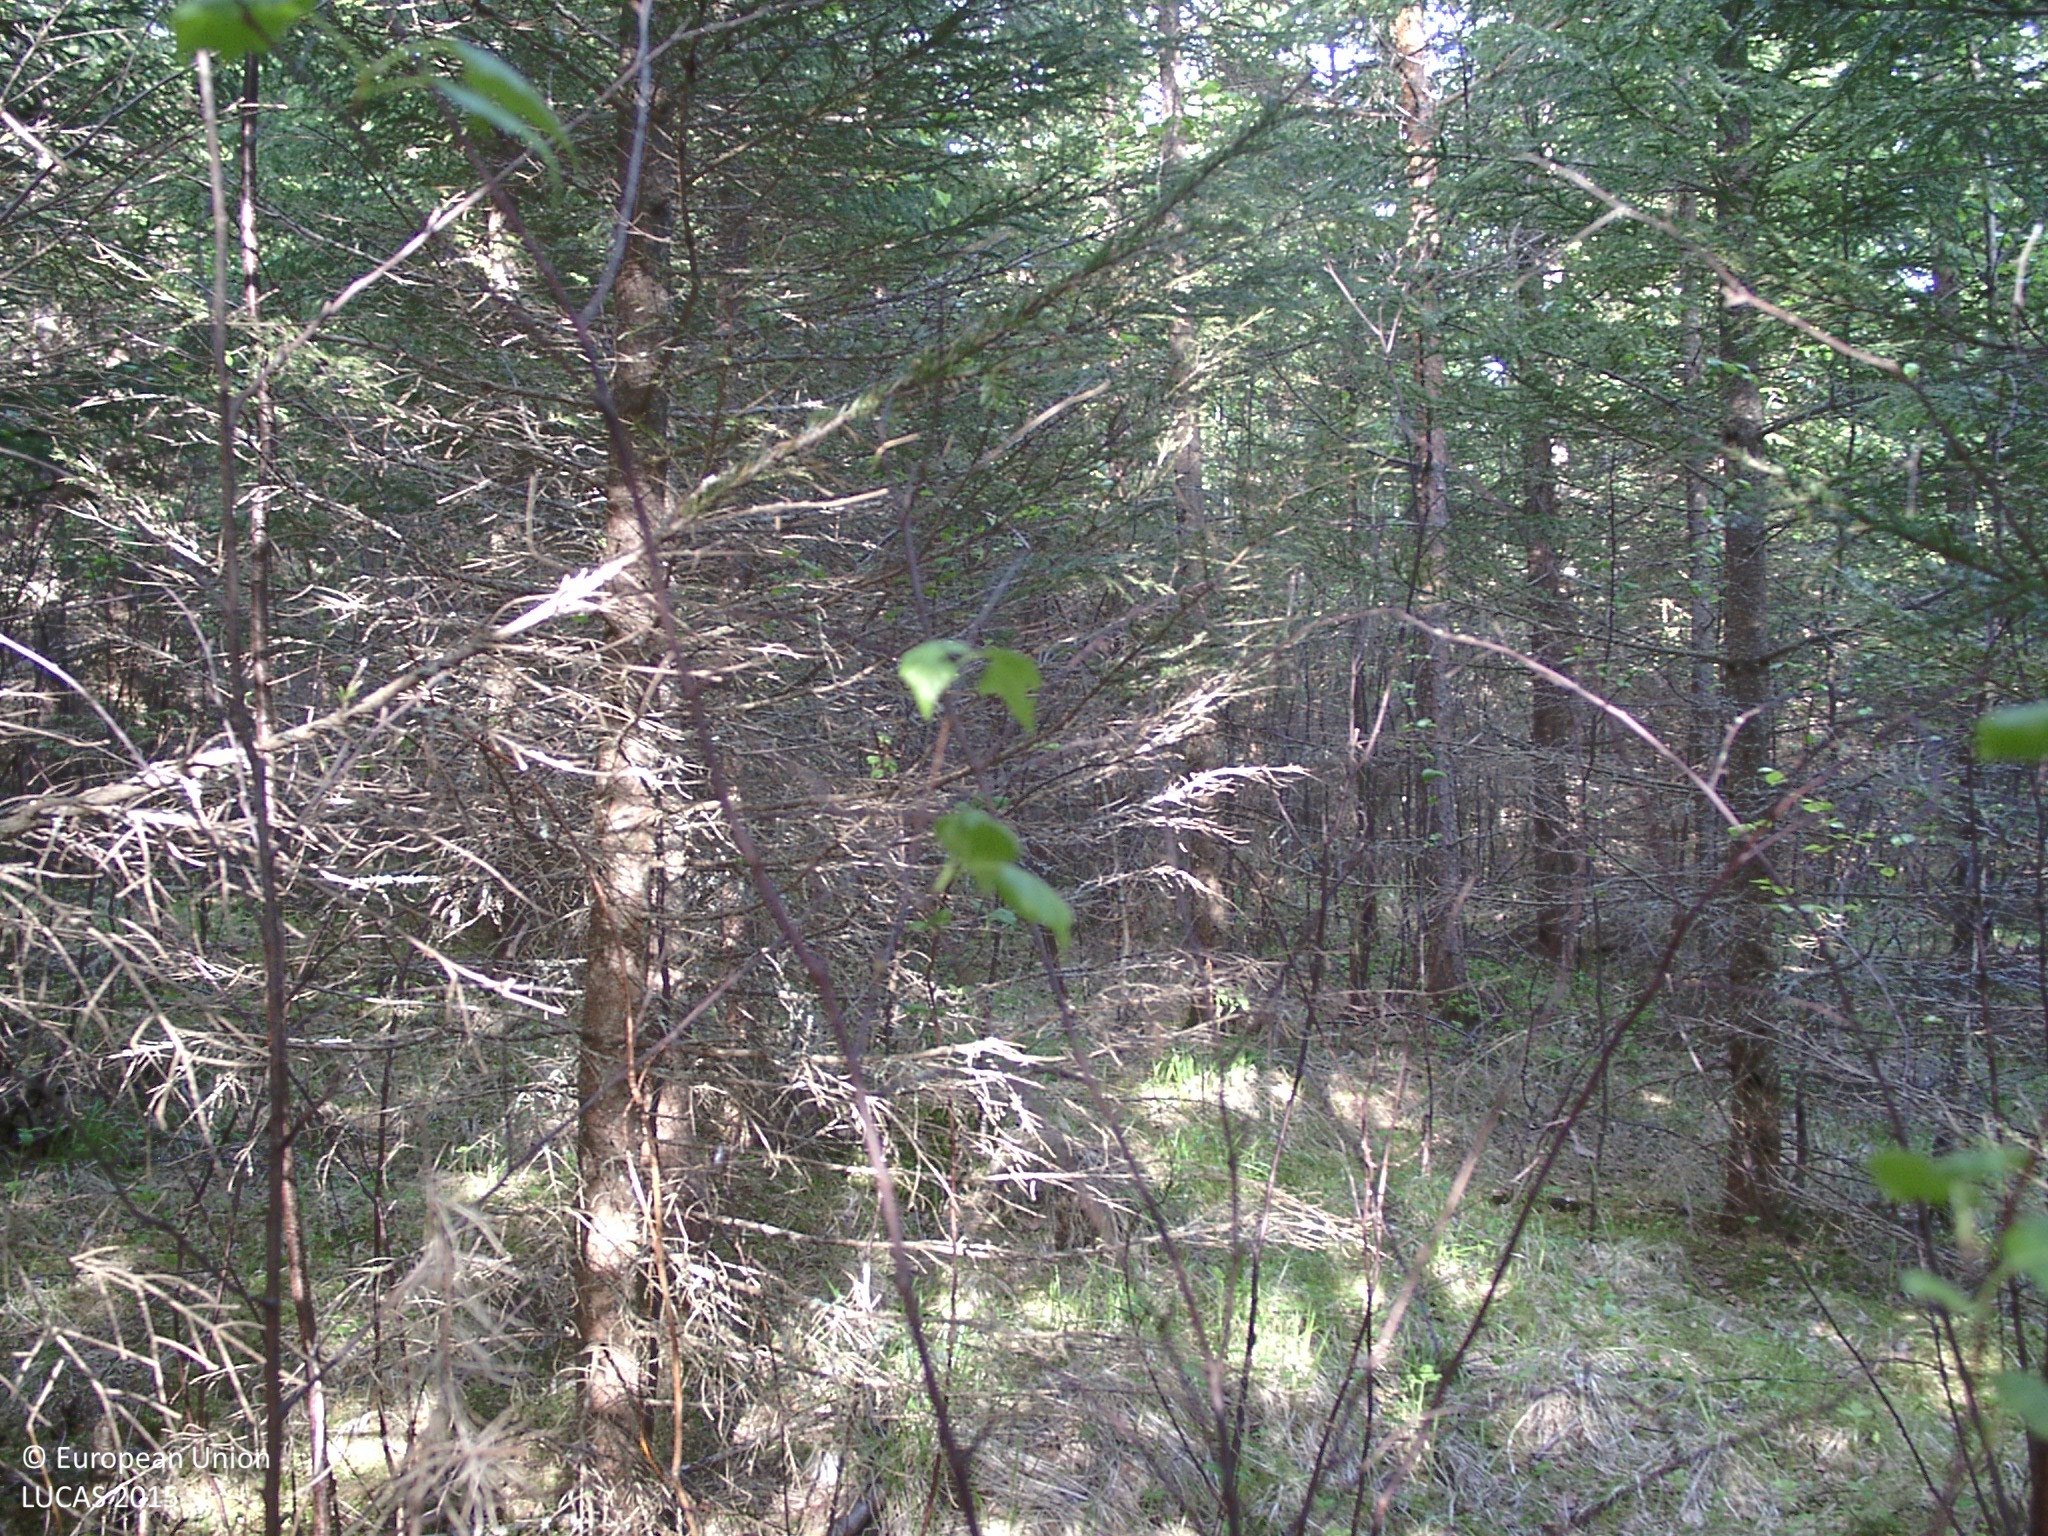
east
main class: Woodland
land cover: Spruce dominated coniferous woodland
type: boreal forest
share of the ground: > 75 %
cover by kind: coniferous forest trees 70 %, broadleaved forest trees 15 %, shrubs 5 %, herbaceous plants 5 %, lichens and mosses 5 %
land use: Forestry
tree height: > 5 m
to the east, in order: Spruce dominated coniferous woodland; Other mixed woodland; Pine dominated mixed woodland; Groves; Ditches and canals; Shruby margins; Tracks; Shruby margins; Ditches and canals; Groves; Broadleaved woodland; Other mixed woodland; Grassland with sparse tree/shrub cover
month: June
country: FI
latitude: 62.1383
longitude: 25.6358
